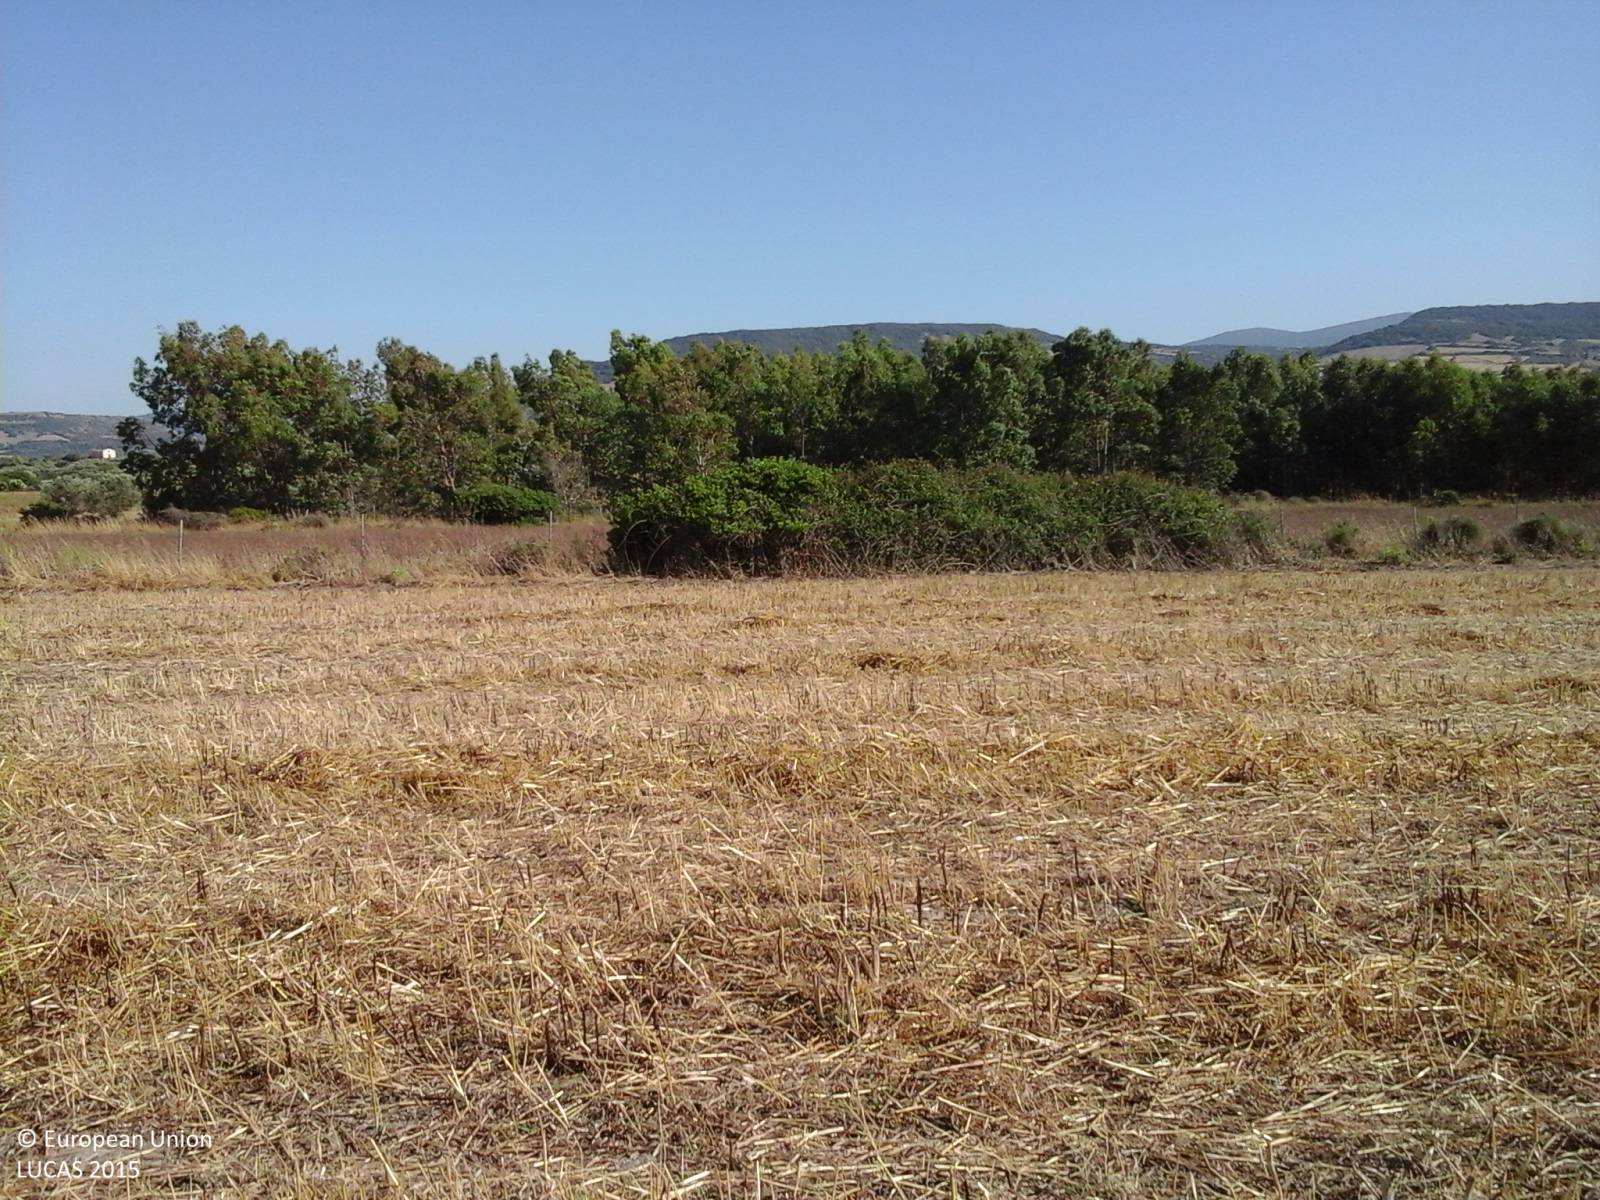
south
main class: Grassland
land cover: Grassland without tree/shrub cover
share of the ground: > 75 %
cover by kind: herbaceous plants 100 %
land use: Agriculture (excluding fallow land and kitchen gardens)
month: June
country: IT
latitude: 39.8976
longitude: 8.7787
